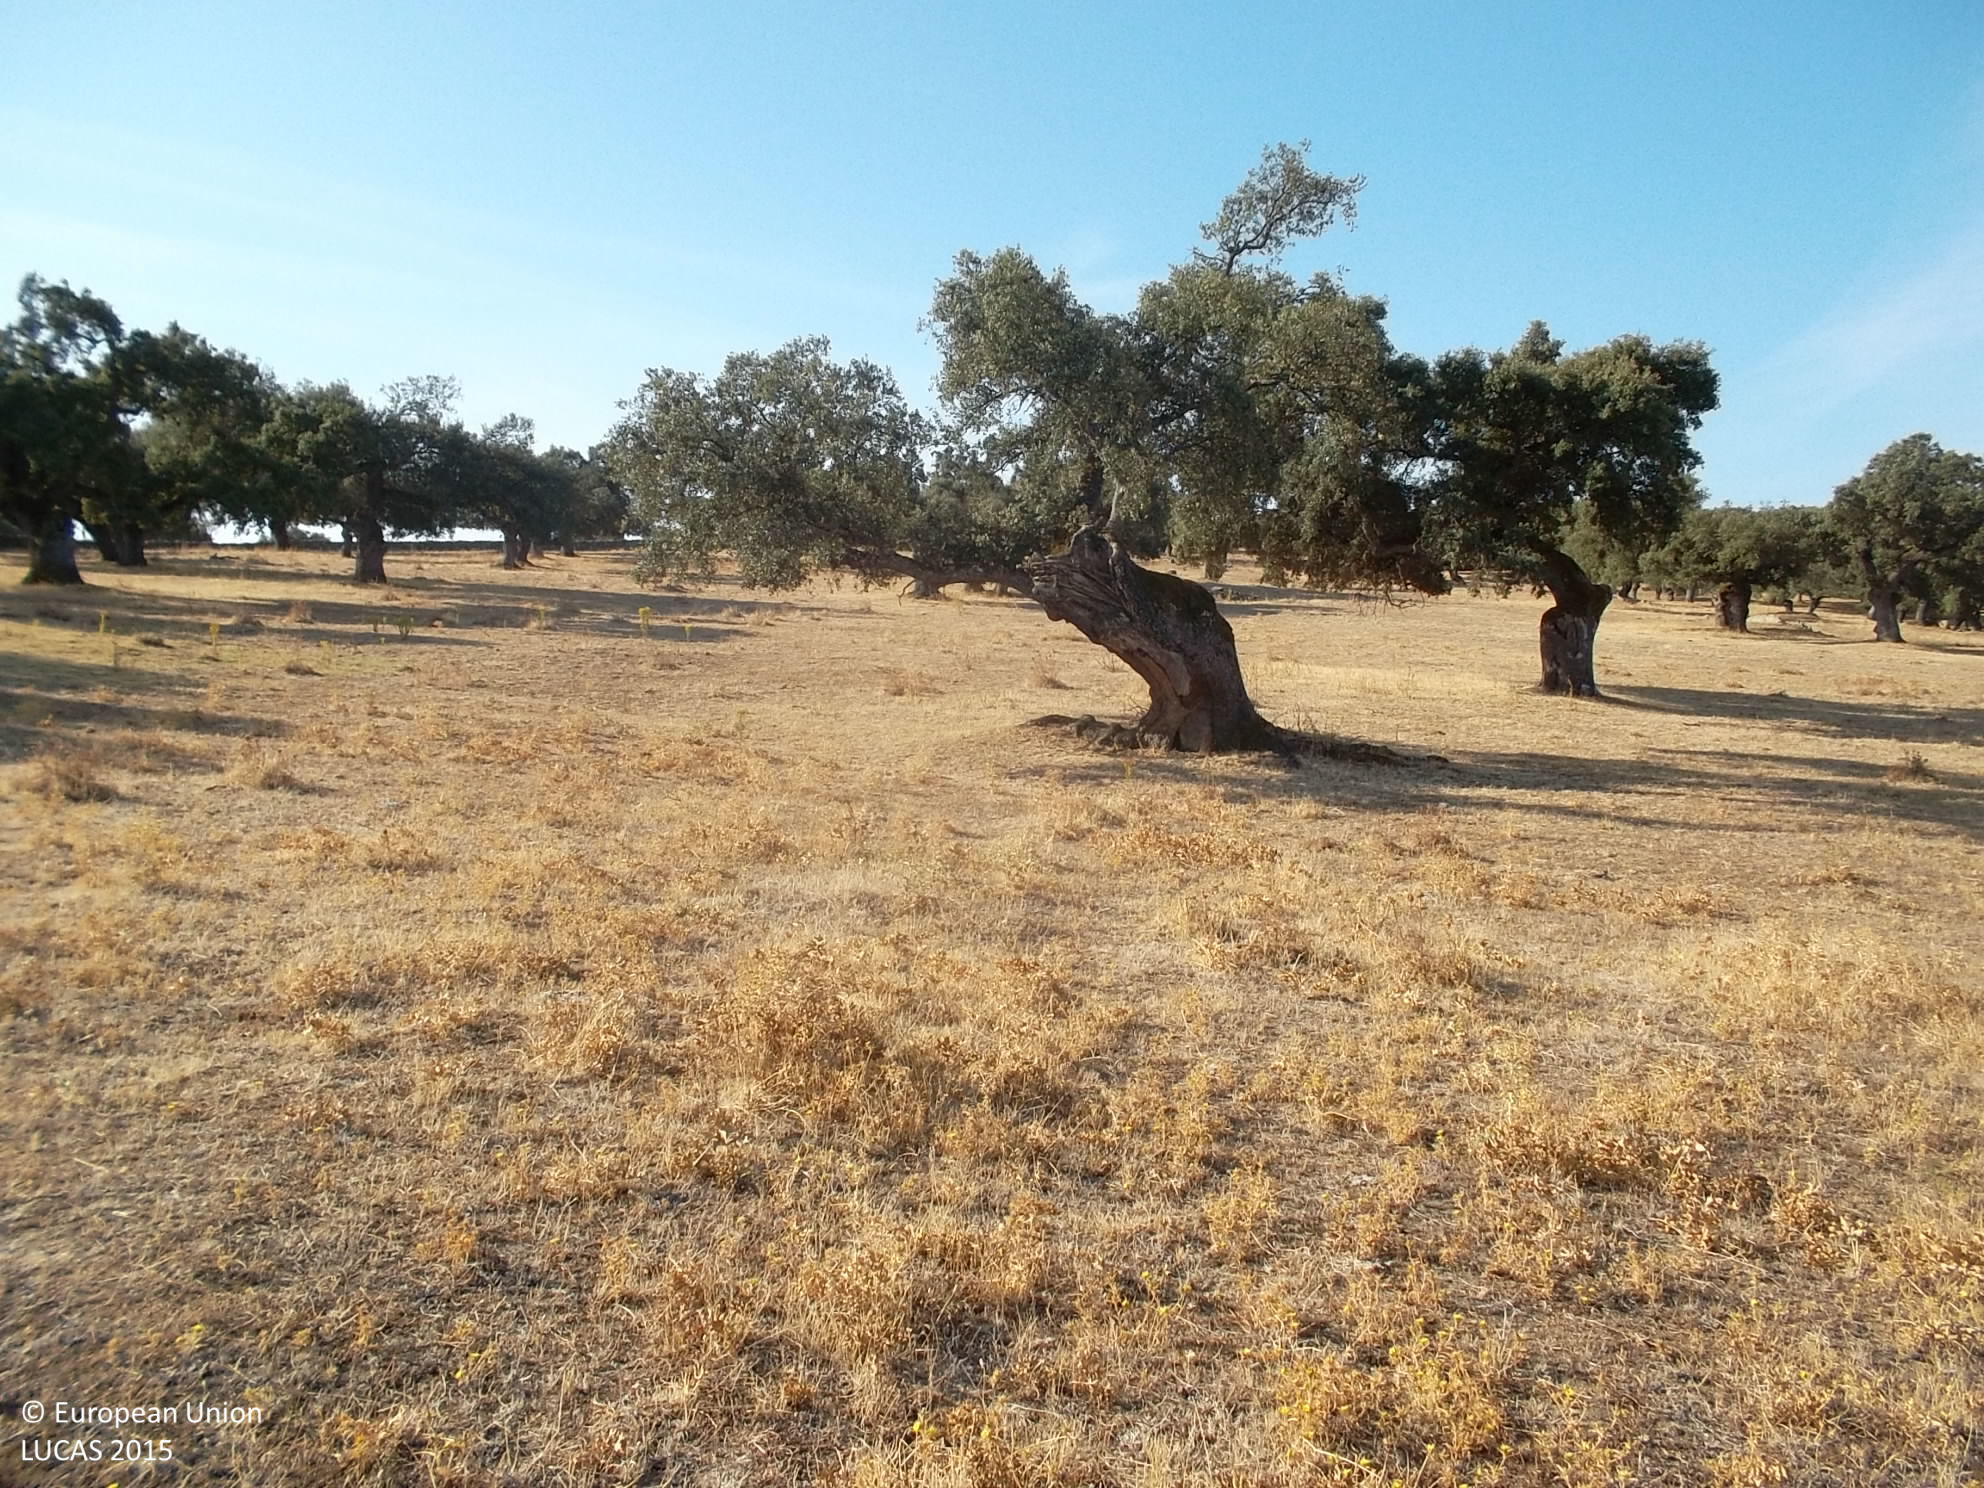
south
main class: Grassland
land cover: Grassland without tree/shrub cover
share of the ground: > 75 %
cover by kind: herbaceous plants 100 %
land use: Agriculture (excluding fallow land and kitchen gardens)
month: September
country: ES
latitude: 38.1740
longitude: -6.5197
